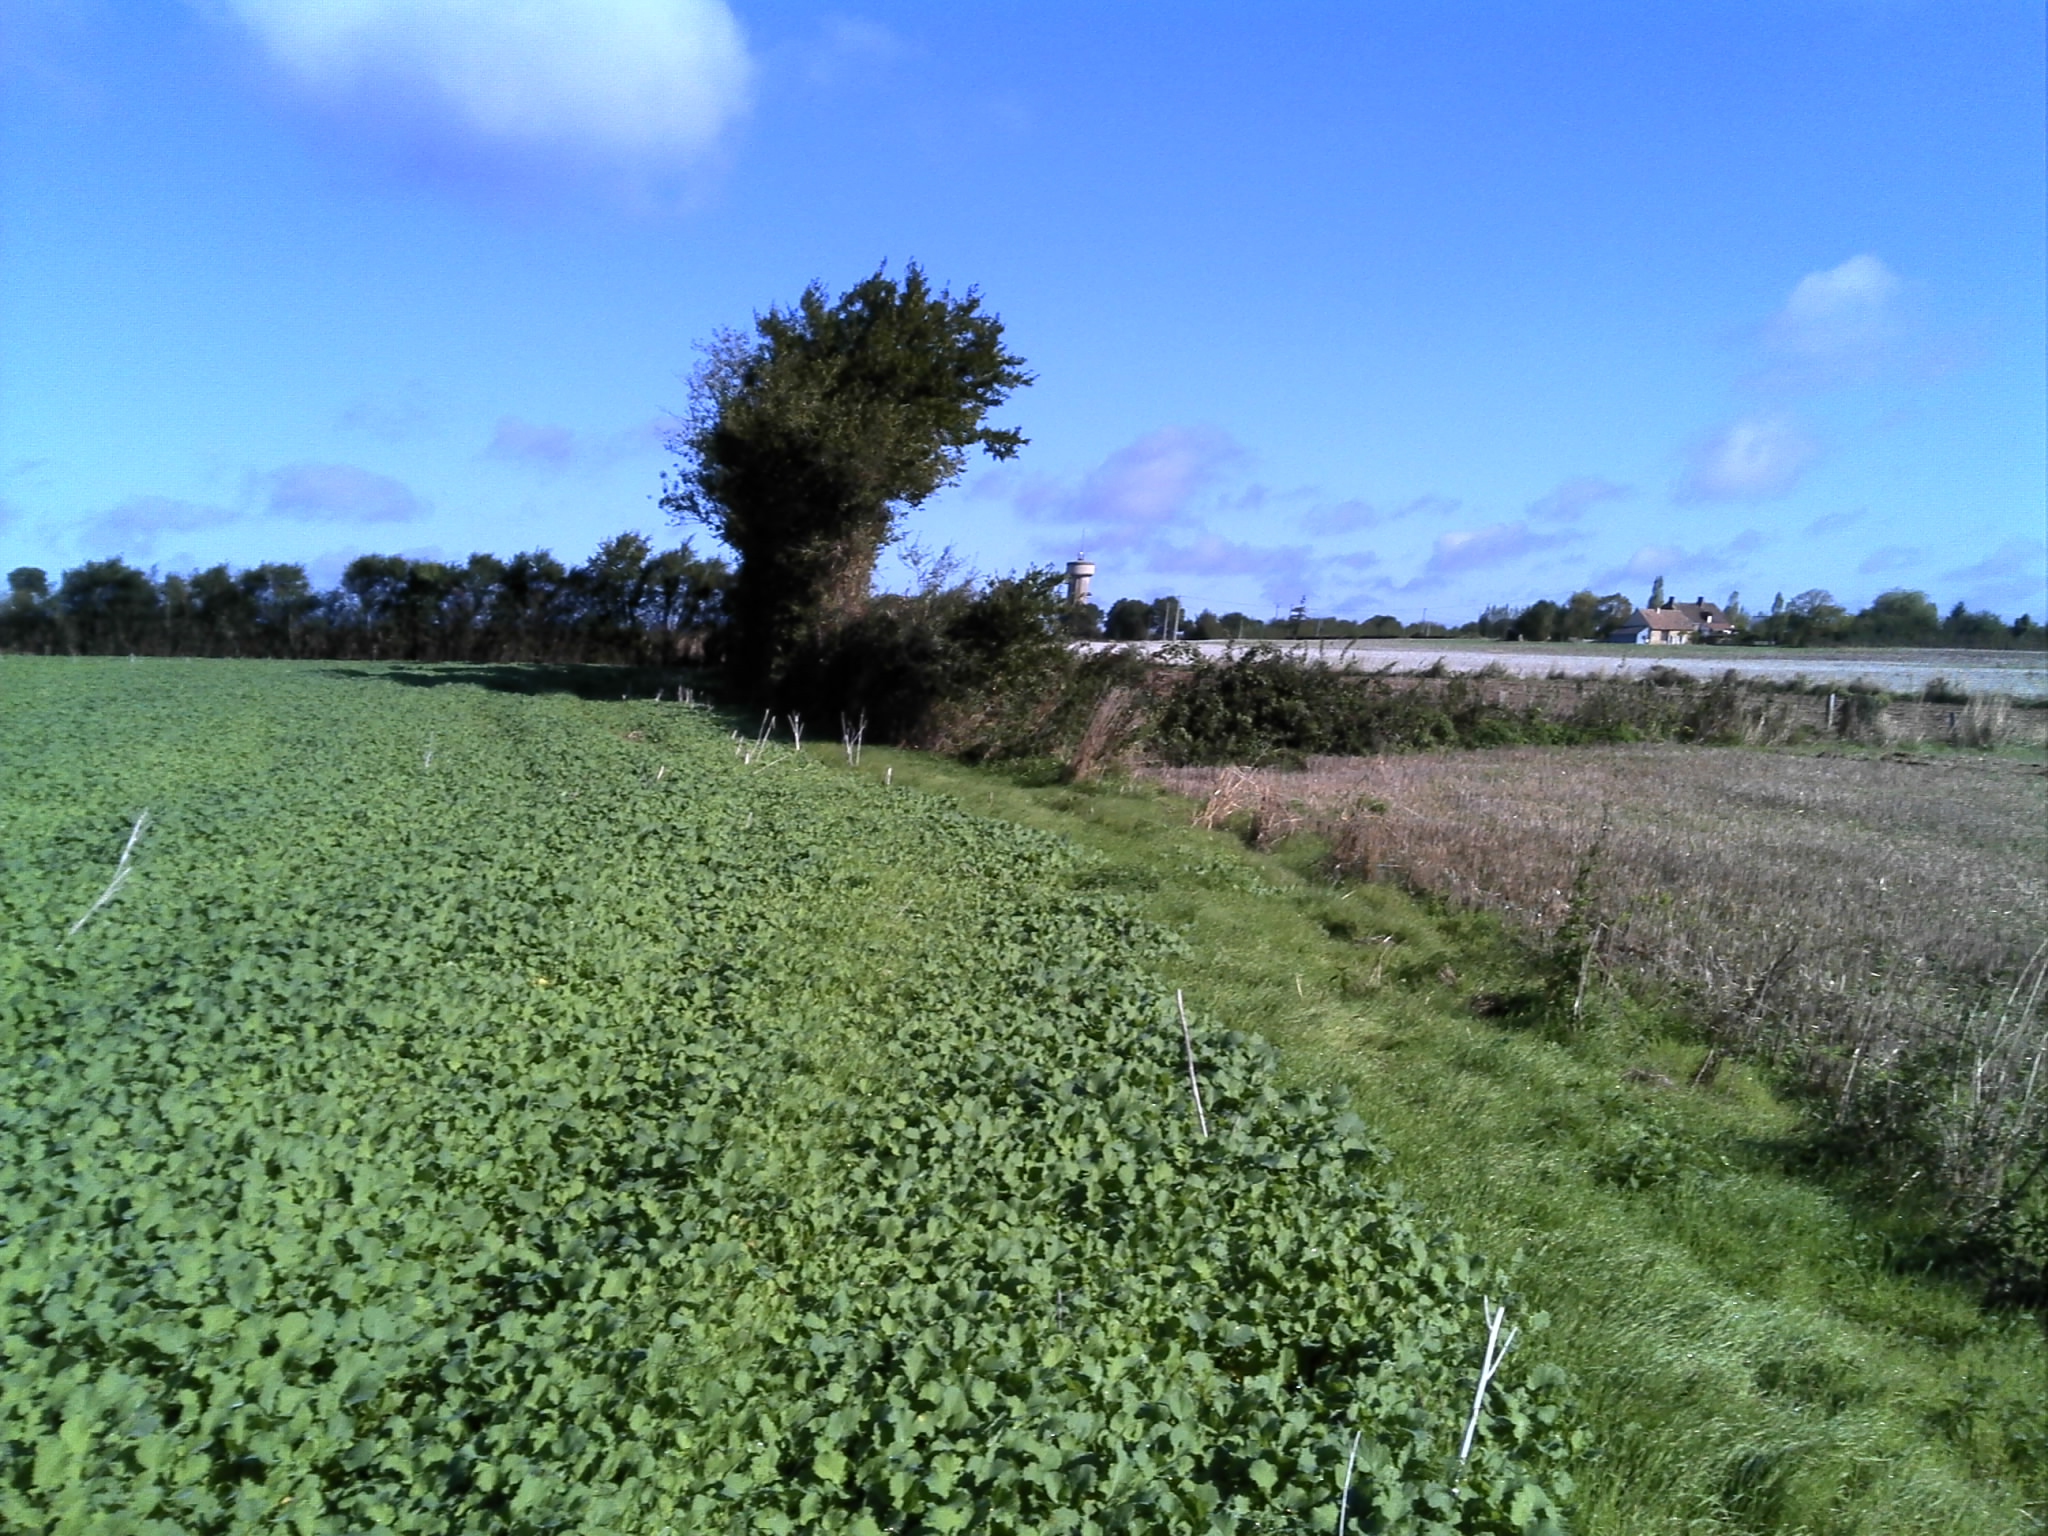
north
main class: Cropland
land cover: Rape and turnip rape
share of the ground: > 75 %
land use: Agriculture (excluding fallow land and kitchen gardens)
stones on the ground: < 10 %
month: September
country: FR
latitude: 47.9340
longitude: 0.6485
